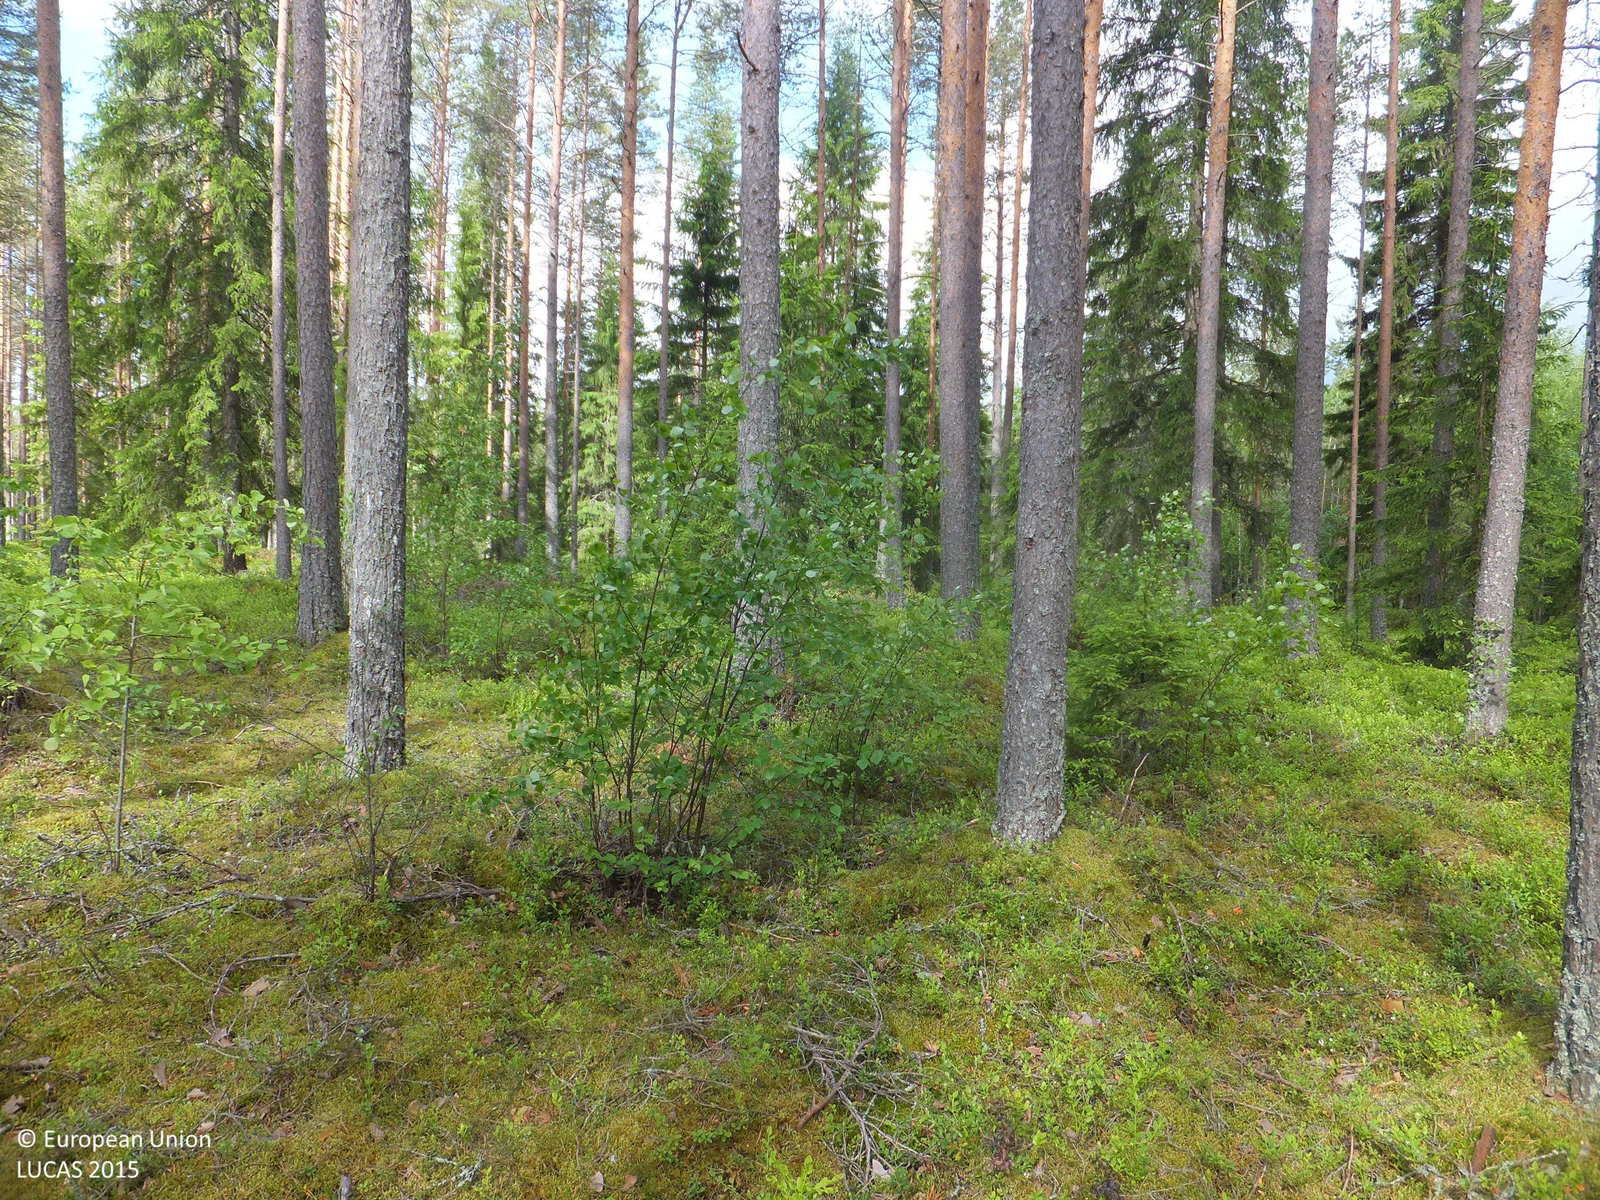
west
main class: Woodland
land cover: Pine dominated coniferous woodland
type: boreal forest
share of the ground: > 75 %
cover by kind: coniferous forest trees 80 %, shrubs 10 %, broadleaved forest trees 5 %, lichens and mosses 5 %
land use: Forestry
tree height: > 5 m
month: June
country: FI
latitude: 63.3961
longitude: 24.1041
